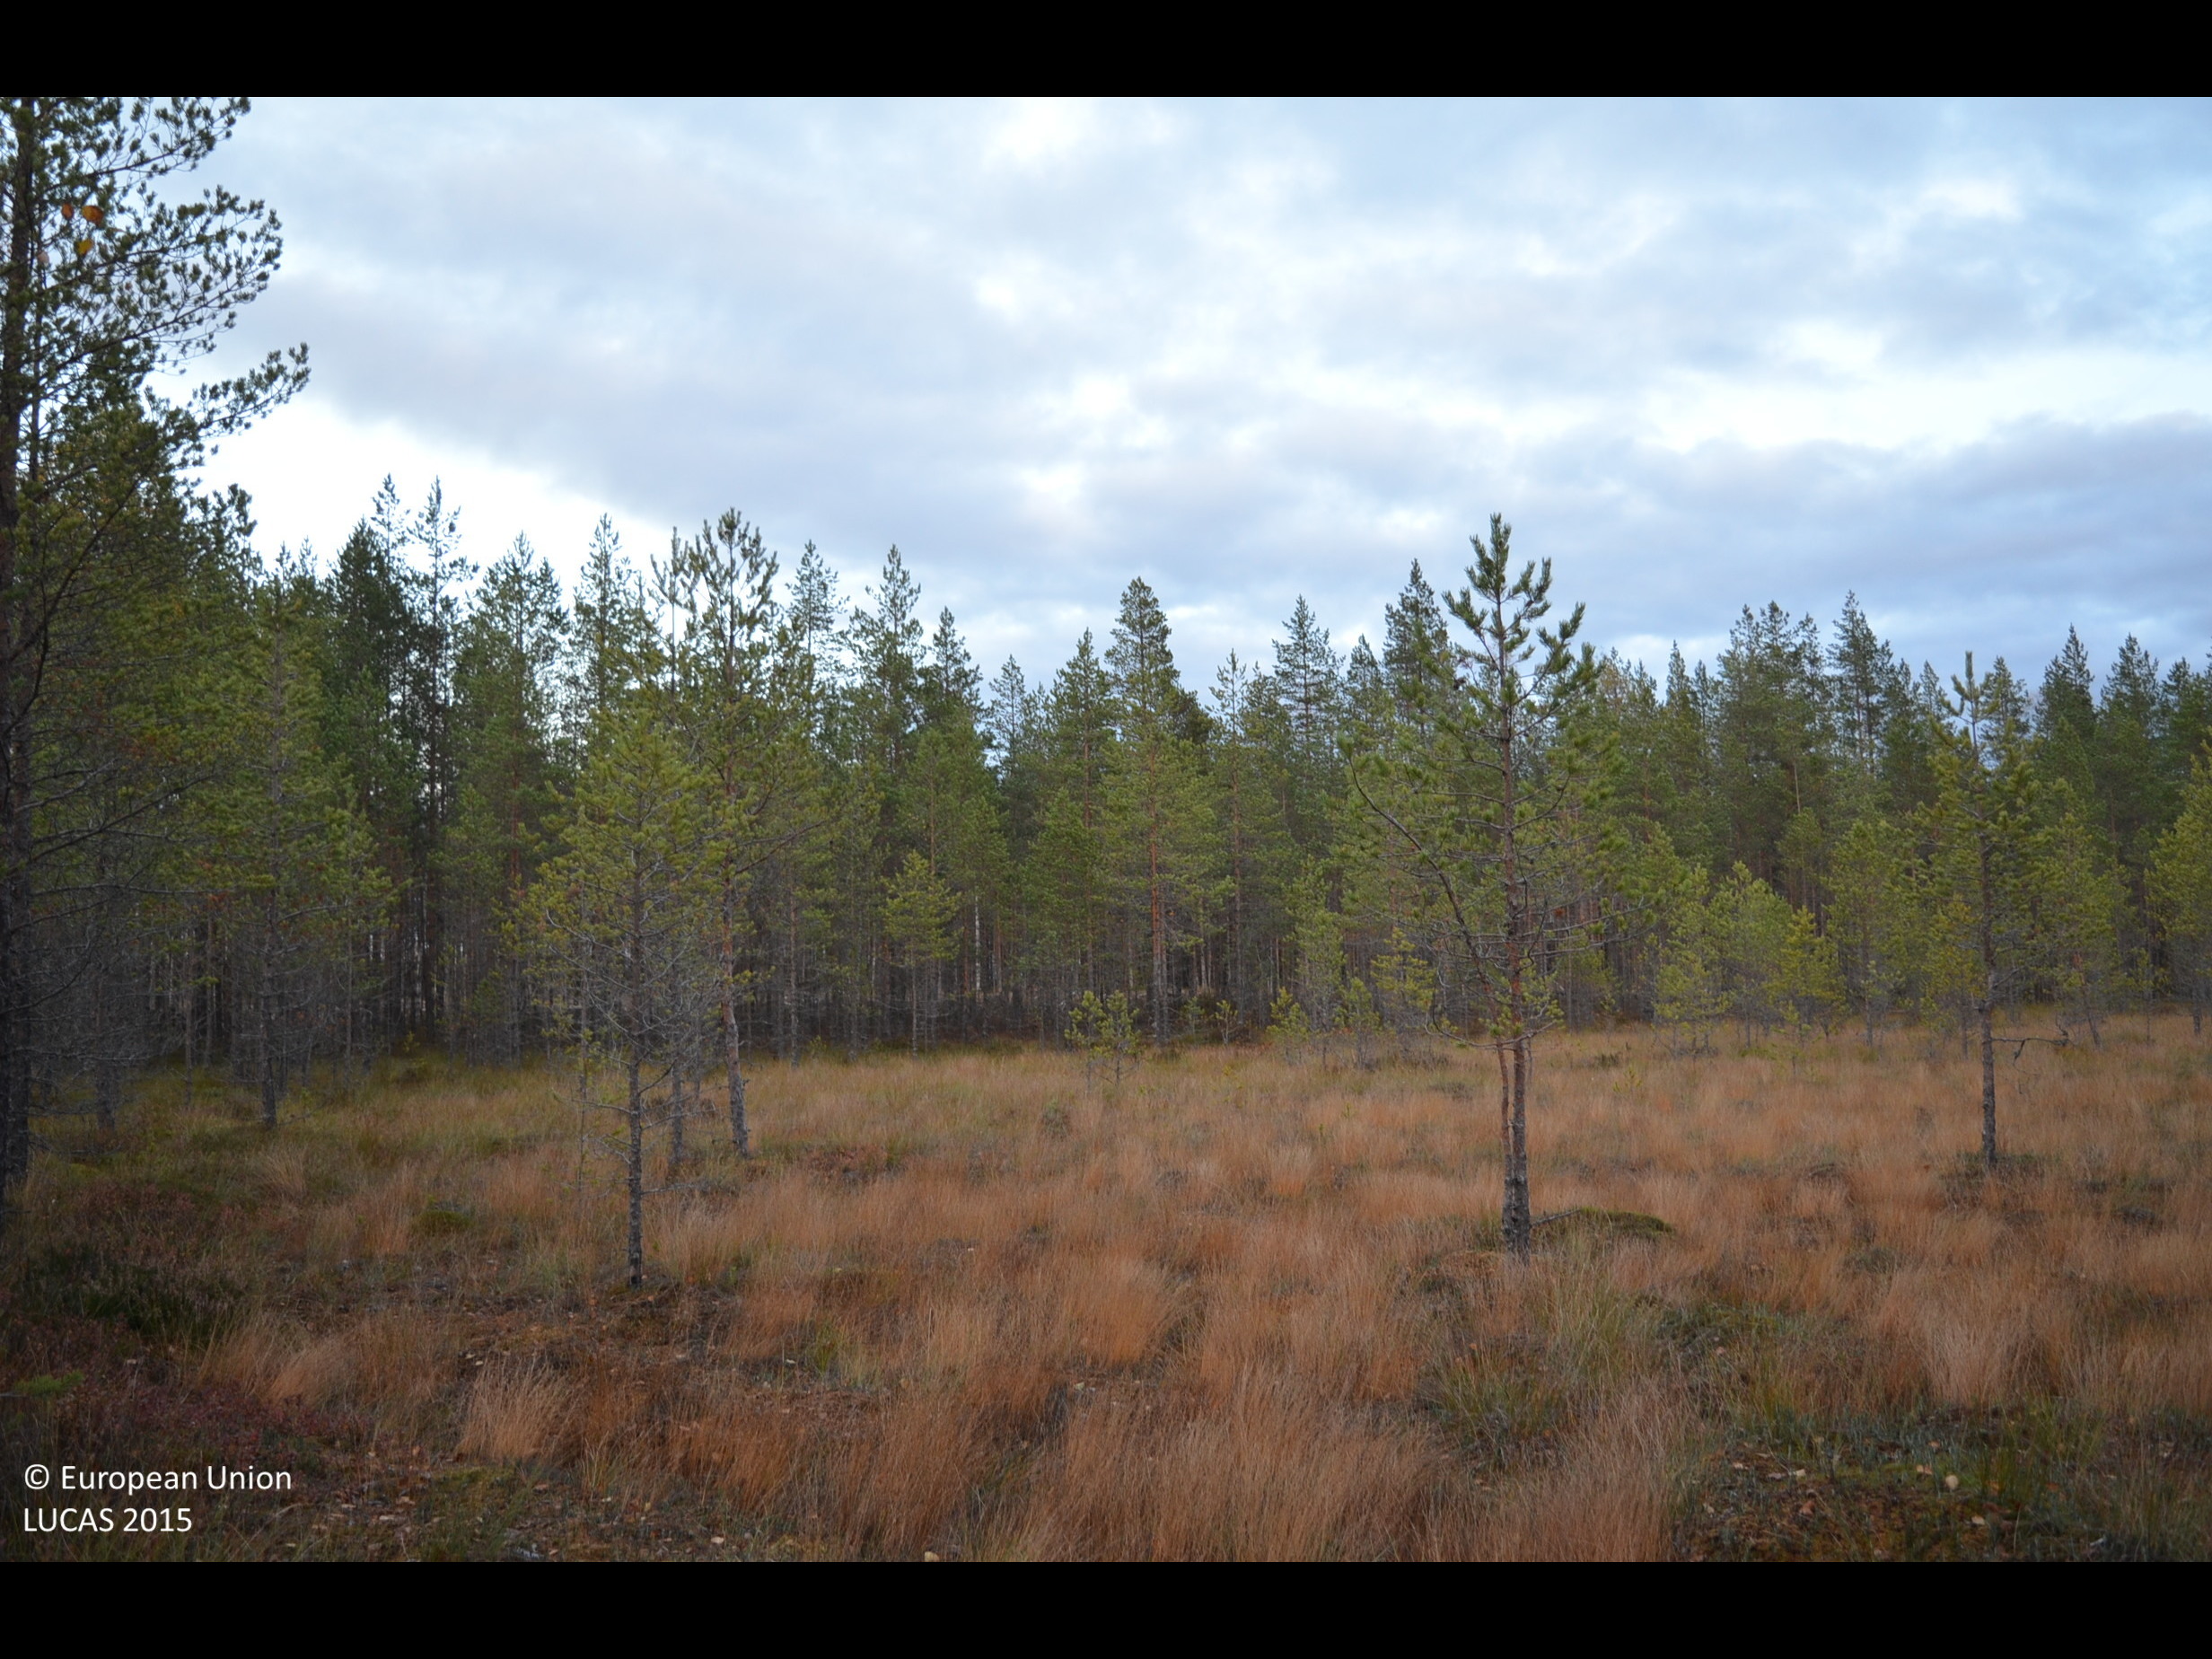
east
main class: Woodland
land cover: Pine dominated mixed woodland
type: mire and swamp forests
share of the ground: 25 - 50 %
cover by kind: coniferous forest trees 30 %, herbaceous plants 20 %, lichens and mosses 20 %, broadleaved forest trees 15 %, shrubs 15 %
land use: Semi-natural and natural areas not in use
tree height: < 5 m
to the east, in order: Pine dominated mixed woodland; Peatbogs; Pine dominated coniferous woodland; Ditches and canals; Shrubland without tree cover; Ditches and canals; Shrubland without tree cover; Ditches and canals; Shrubland without tree cover; Ditches and canals; Shrubland without tree cover; Ditches and canals; Shrubland with sparse tree cover; Ditches and canals; Shrubland with sparse tree cover; Pine dominated coniferous woodland; Ditches and canals; Pine dominated coniferous woodland; Ditches and canals; Pine dominated mixed woodland; Ditches and canals; Broadleaved woodland; Tracks; Broadleaved woodland; Ditches and canals; Pine dominated mixed woodland; Peatbogs
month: October
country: FI
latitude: 62.3319
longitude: 23.4887
